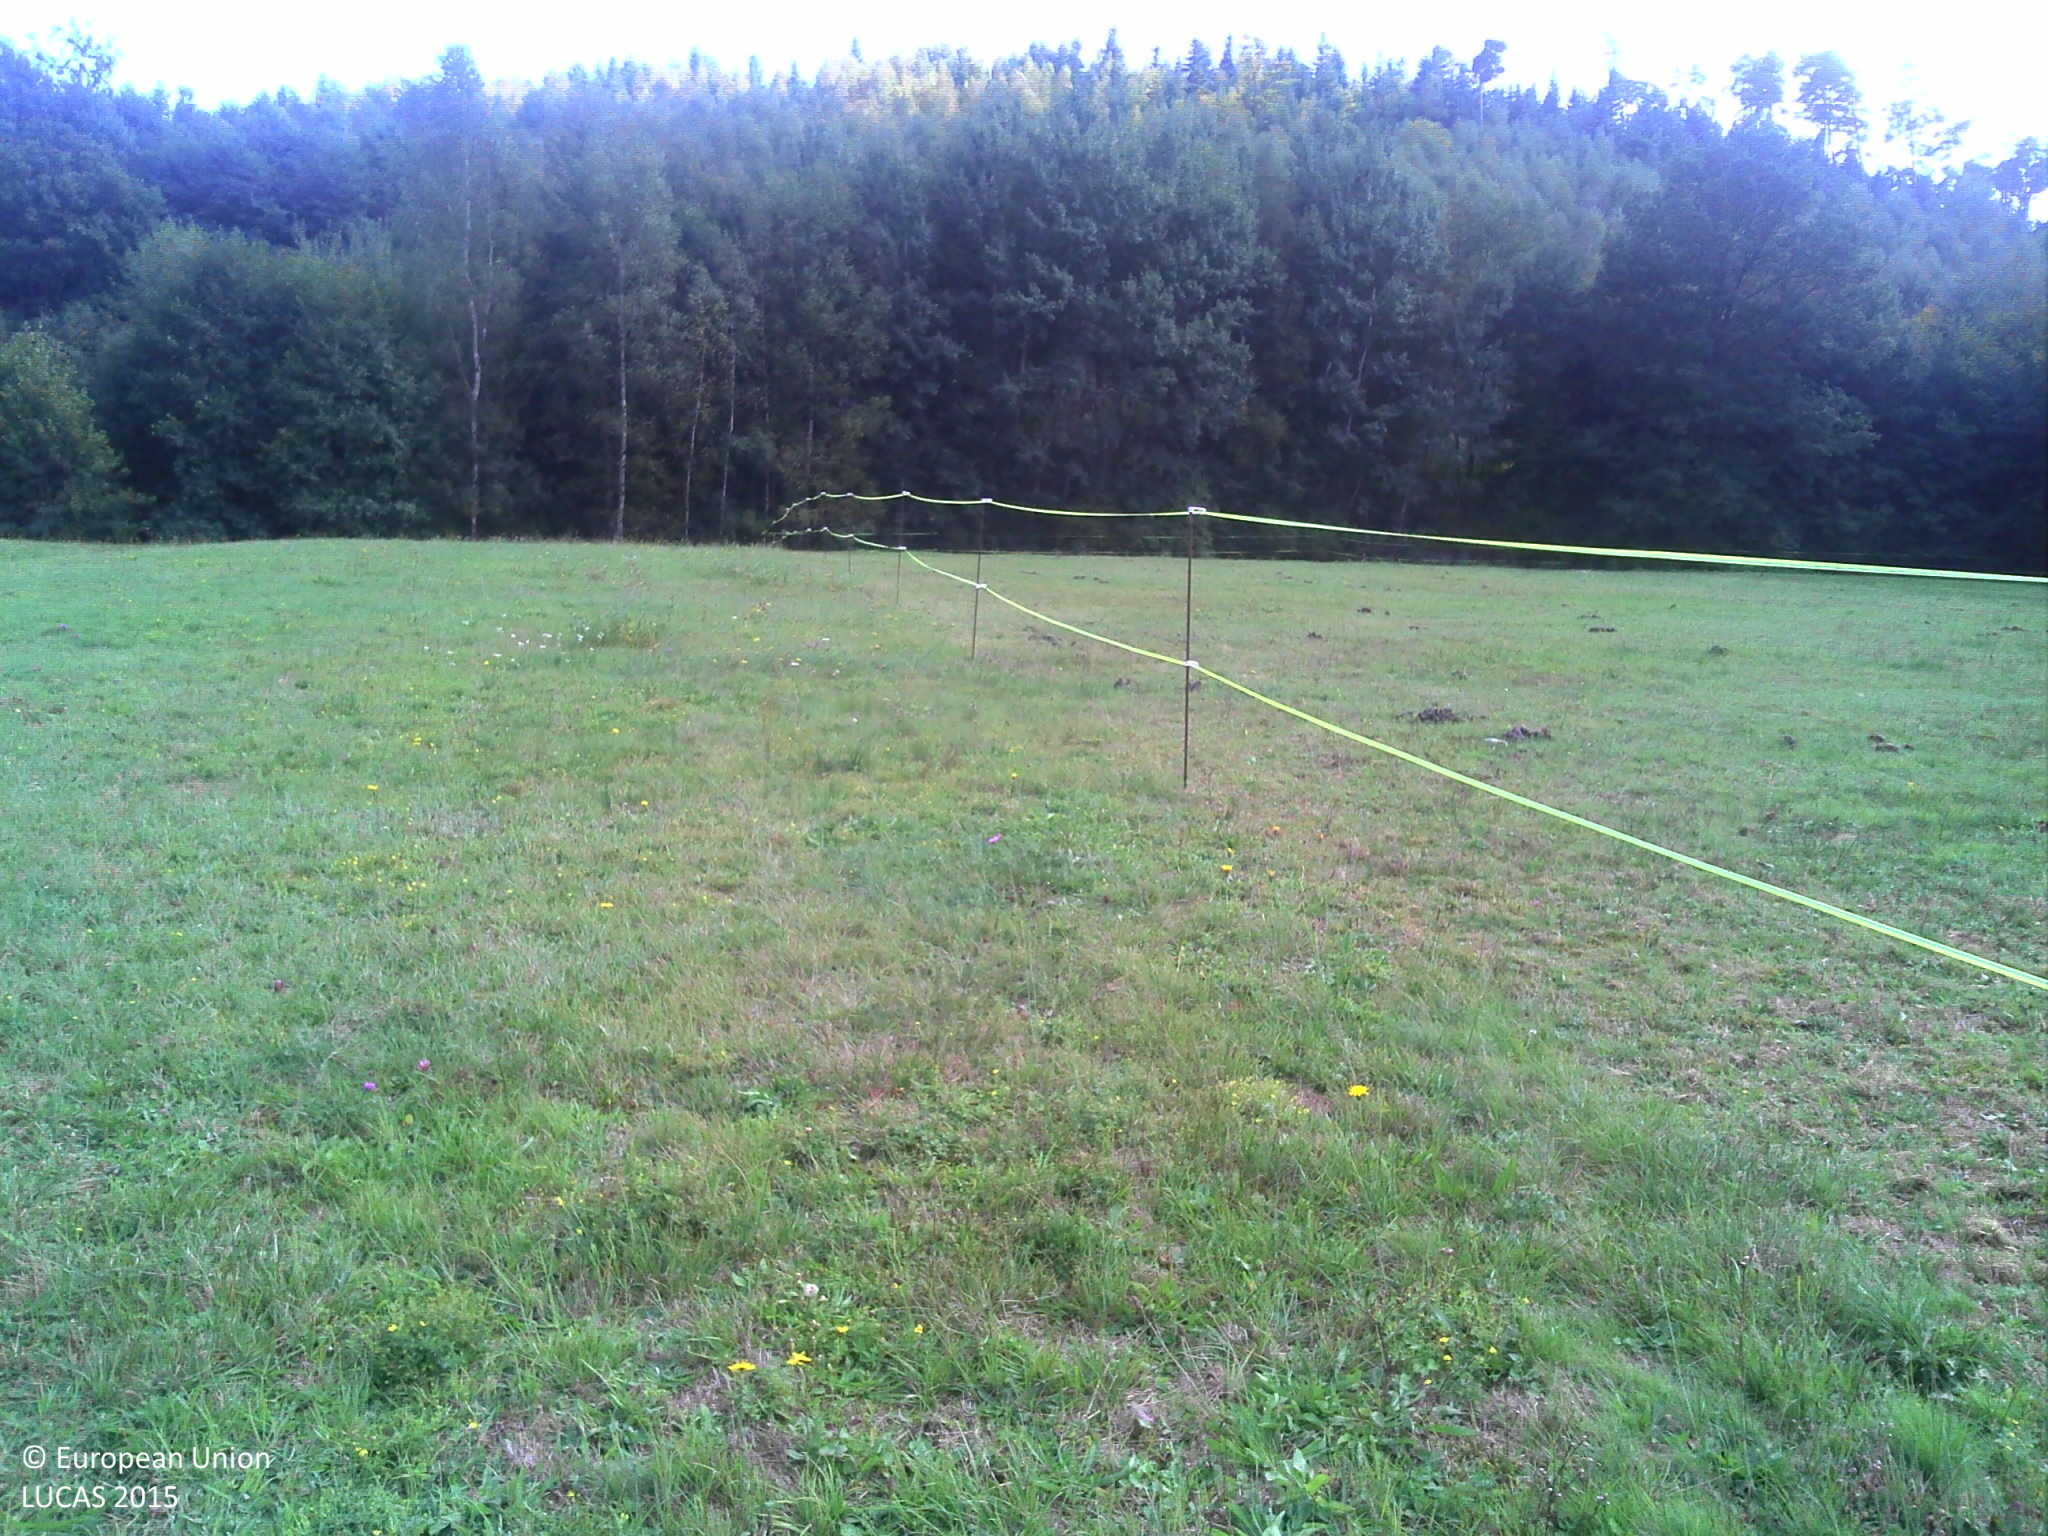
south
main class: Grassland
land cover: Grassland without tree/shrub cover
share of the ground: > 75 %
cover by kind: herbaceous plants 95 %, consolidated bare surface 5 %
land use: Agriculture (excluding fallow land and kitchen gardens)
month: September
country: FR
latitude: 48.4112
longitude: 6.7988
